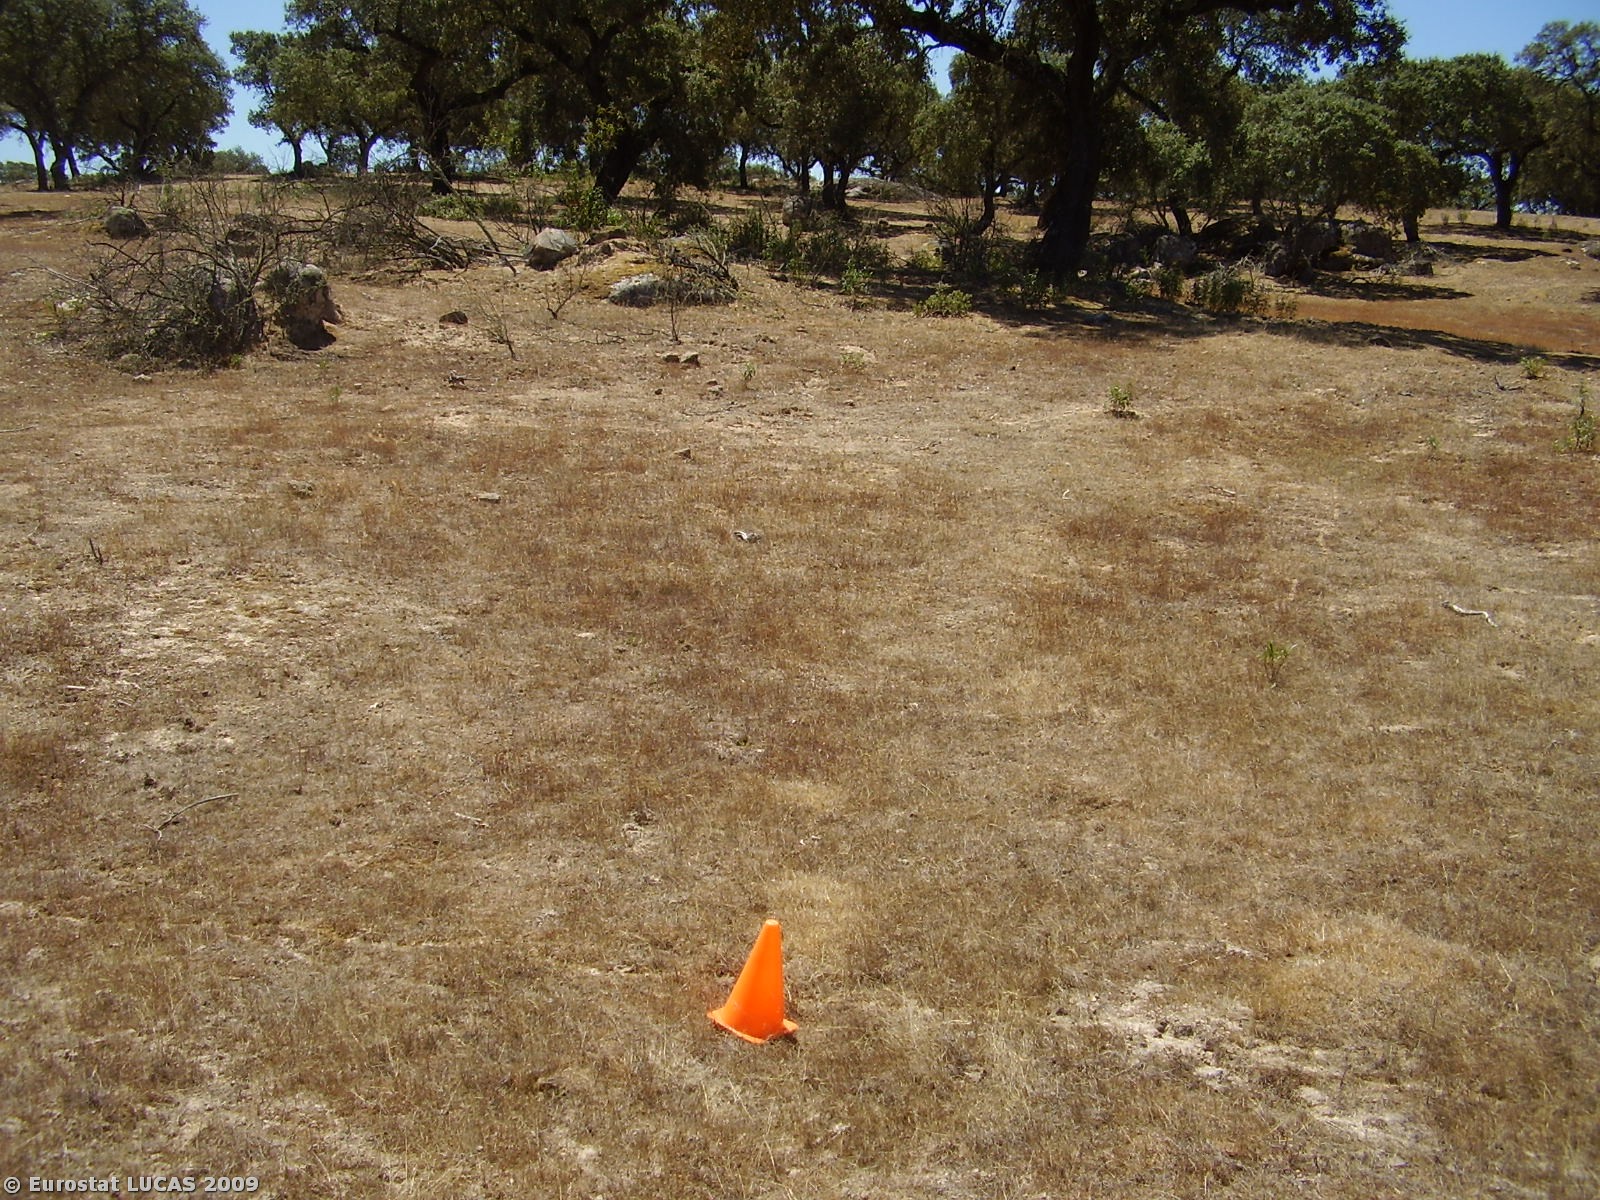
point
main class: Woodland
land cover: Broadleaved woodland
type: broadleaved evergreen forest
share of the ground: 10 - 25 %
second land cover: Grassland with sparse tree/shrub cover
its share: 50 - 75 %
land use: Forestry
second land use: Agriculture (excluding fallow land and kitchen gardens)
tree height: > 5 m
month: July
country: PT
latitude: 38.8743
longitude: -7.9466
